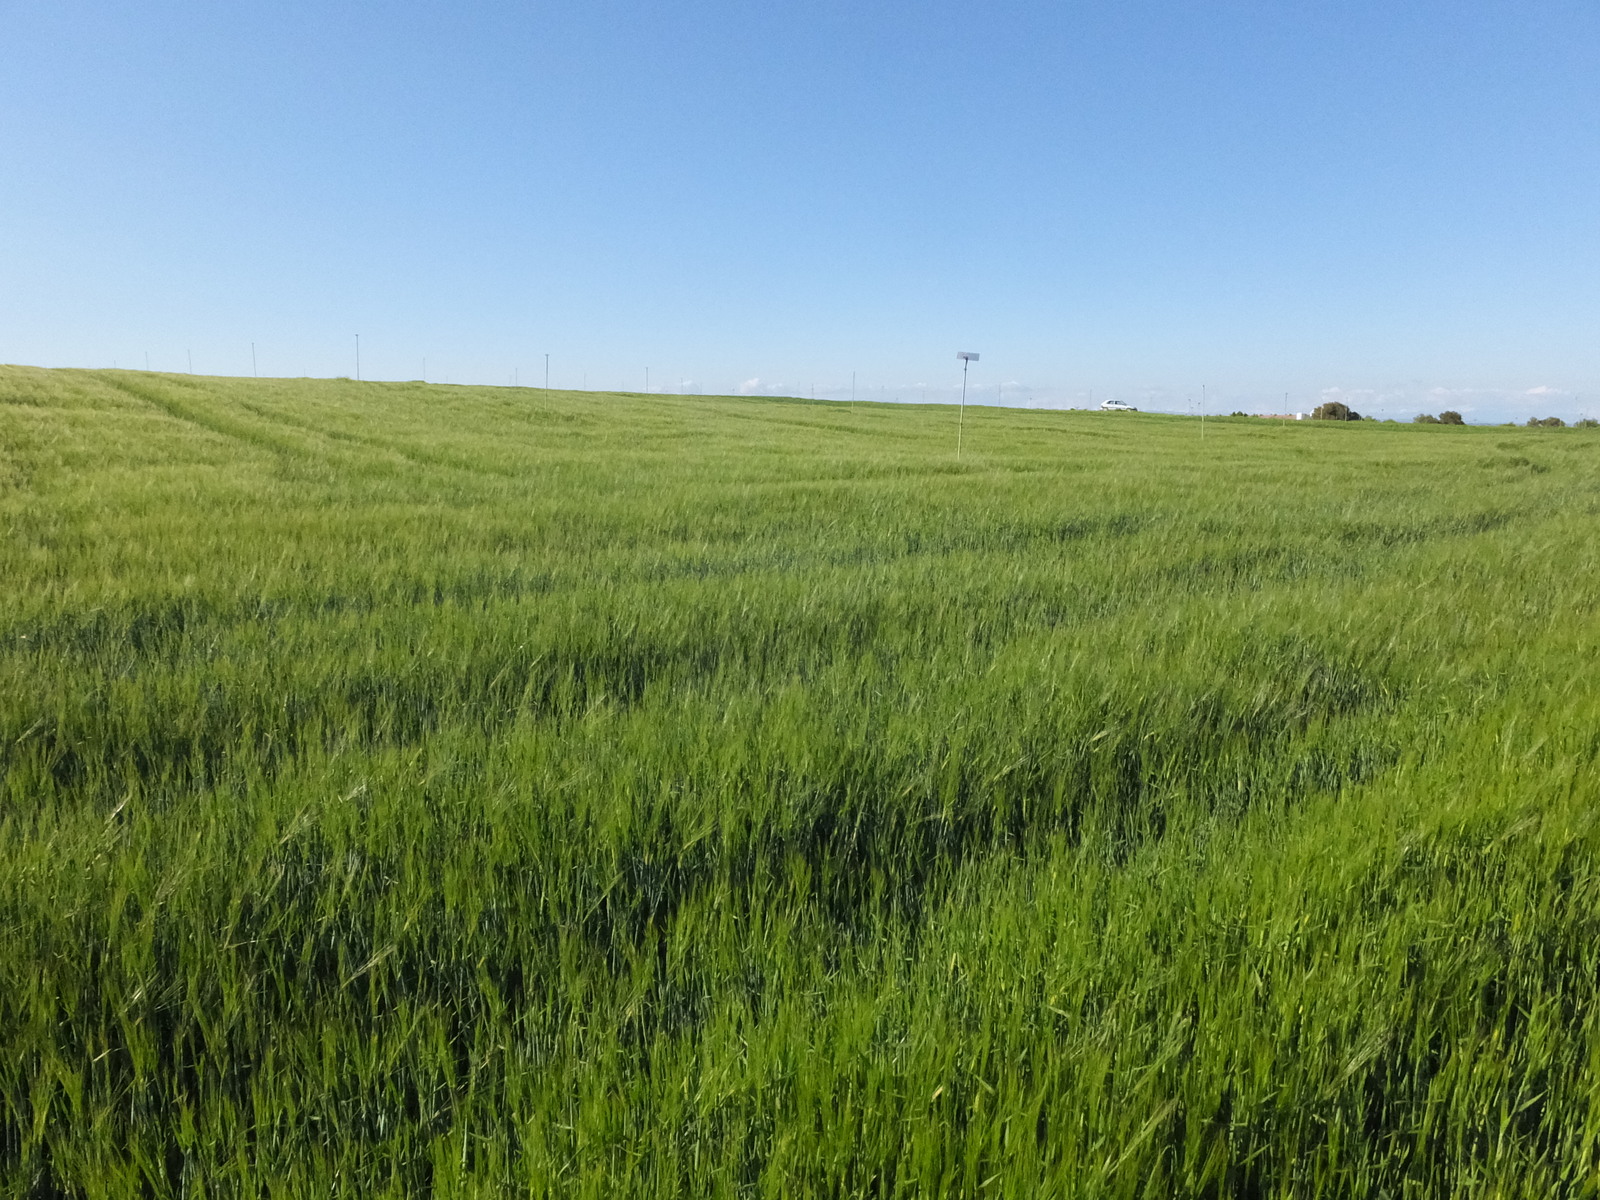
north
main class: Grassland
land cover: Grassland with sparse tree/shrub cover
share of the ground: > 75 %
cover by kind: herbaceous plants 90 %, coniferous forest trees 5 %, shrubs 5 %
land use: Semi-natural and natural areas not in use
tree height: < 5 m
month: April
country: ES
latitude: 41.7016
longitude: -0.1957
